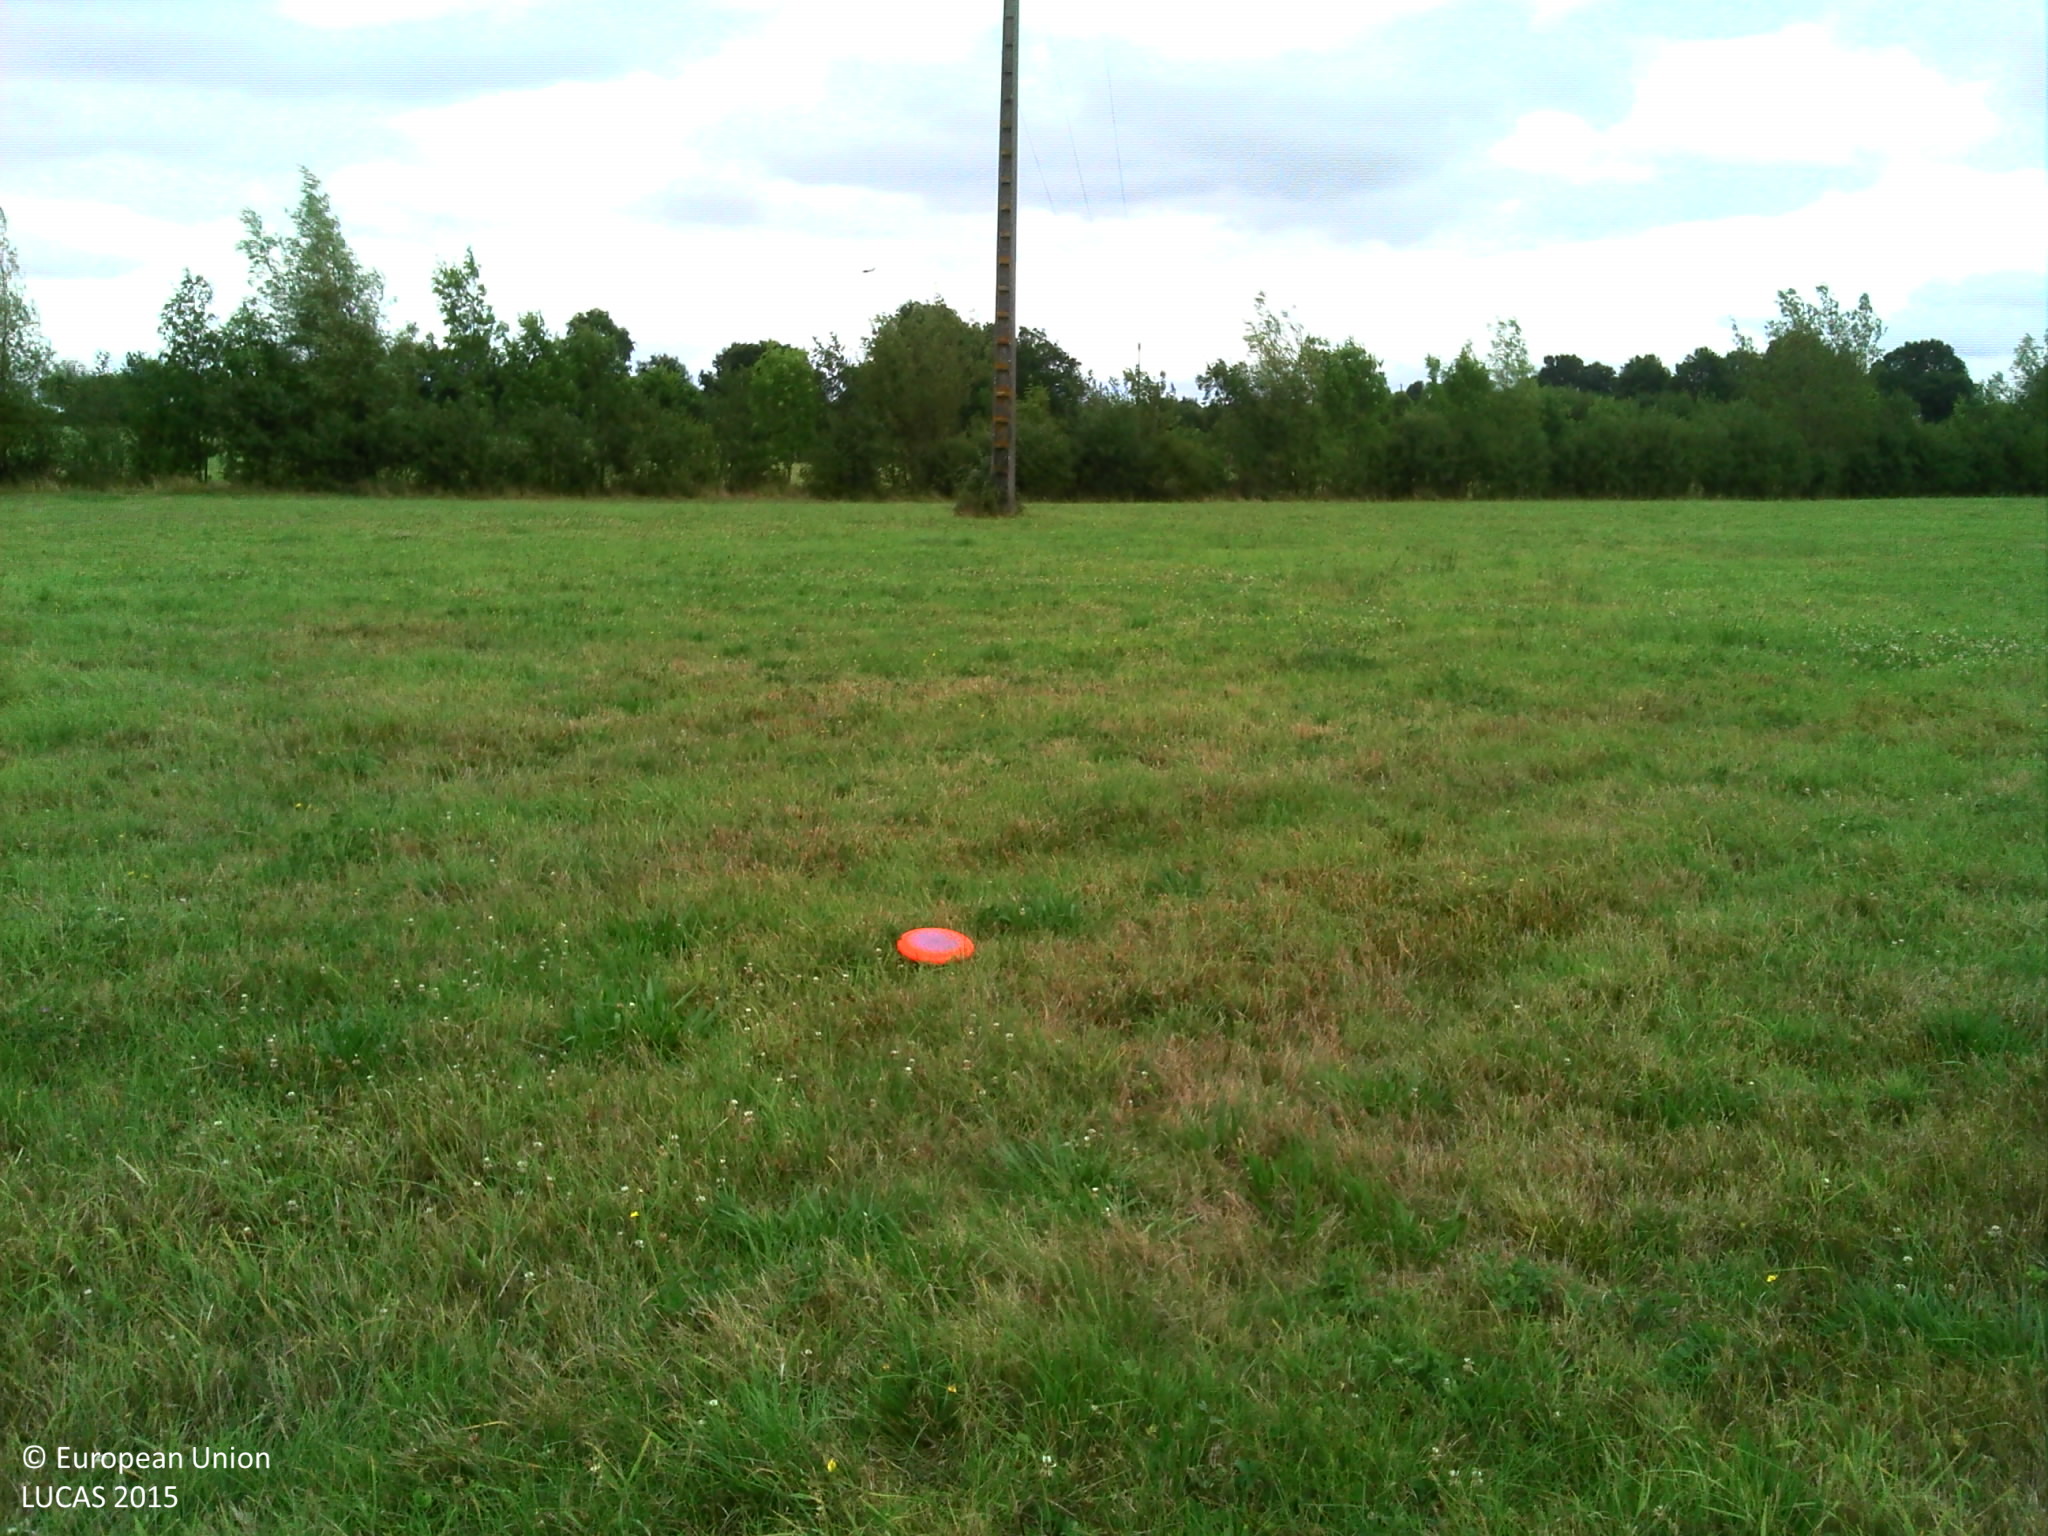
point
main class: Grassland
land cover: Grassland without tree/shrub cover
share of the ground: > 75 %
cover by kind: herbaceous plants 100 %
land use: Agriculture (excluding fallow land and kitchen gardens)
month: July
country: FR
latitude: 48.4320
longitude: -0.0722
